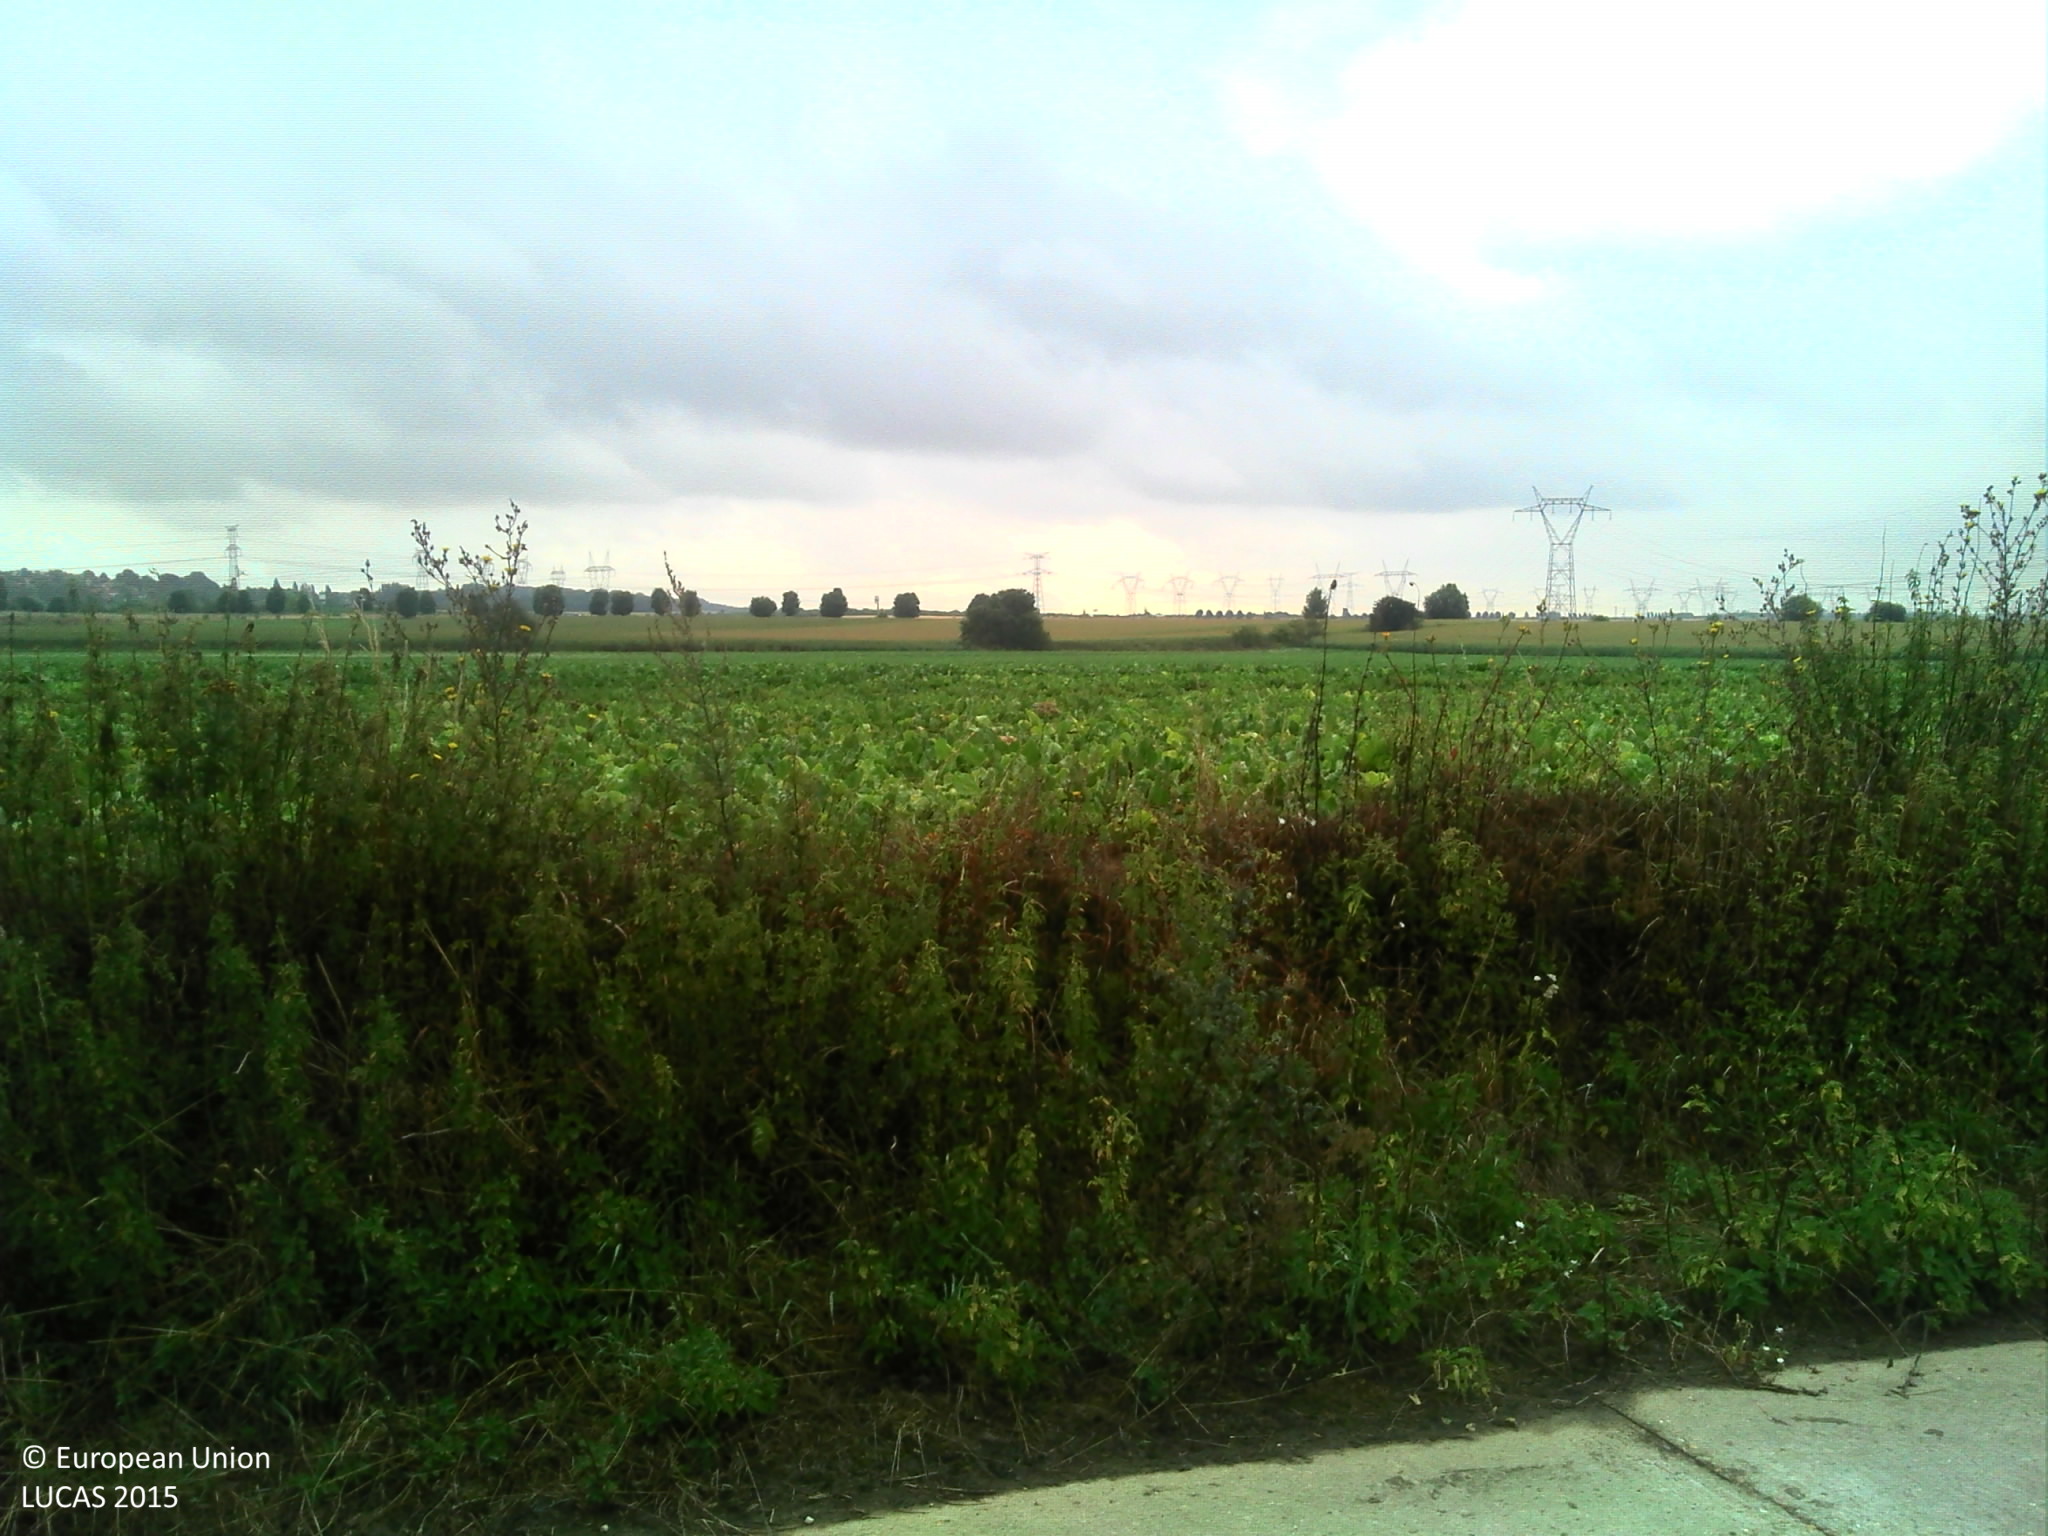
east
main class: Cropland
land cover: Maize
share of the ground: > 75 %
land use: Agriculture (excluding fallow land and kitchen gardens)
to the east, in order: Maize; Grass margins; Tracks; Grass margins; Sugar beet
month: August
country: FR
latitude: 49.0627
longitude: 2.3921
